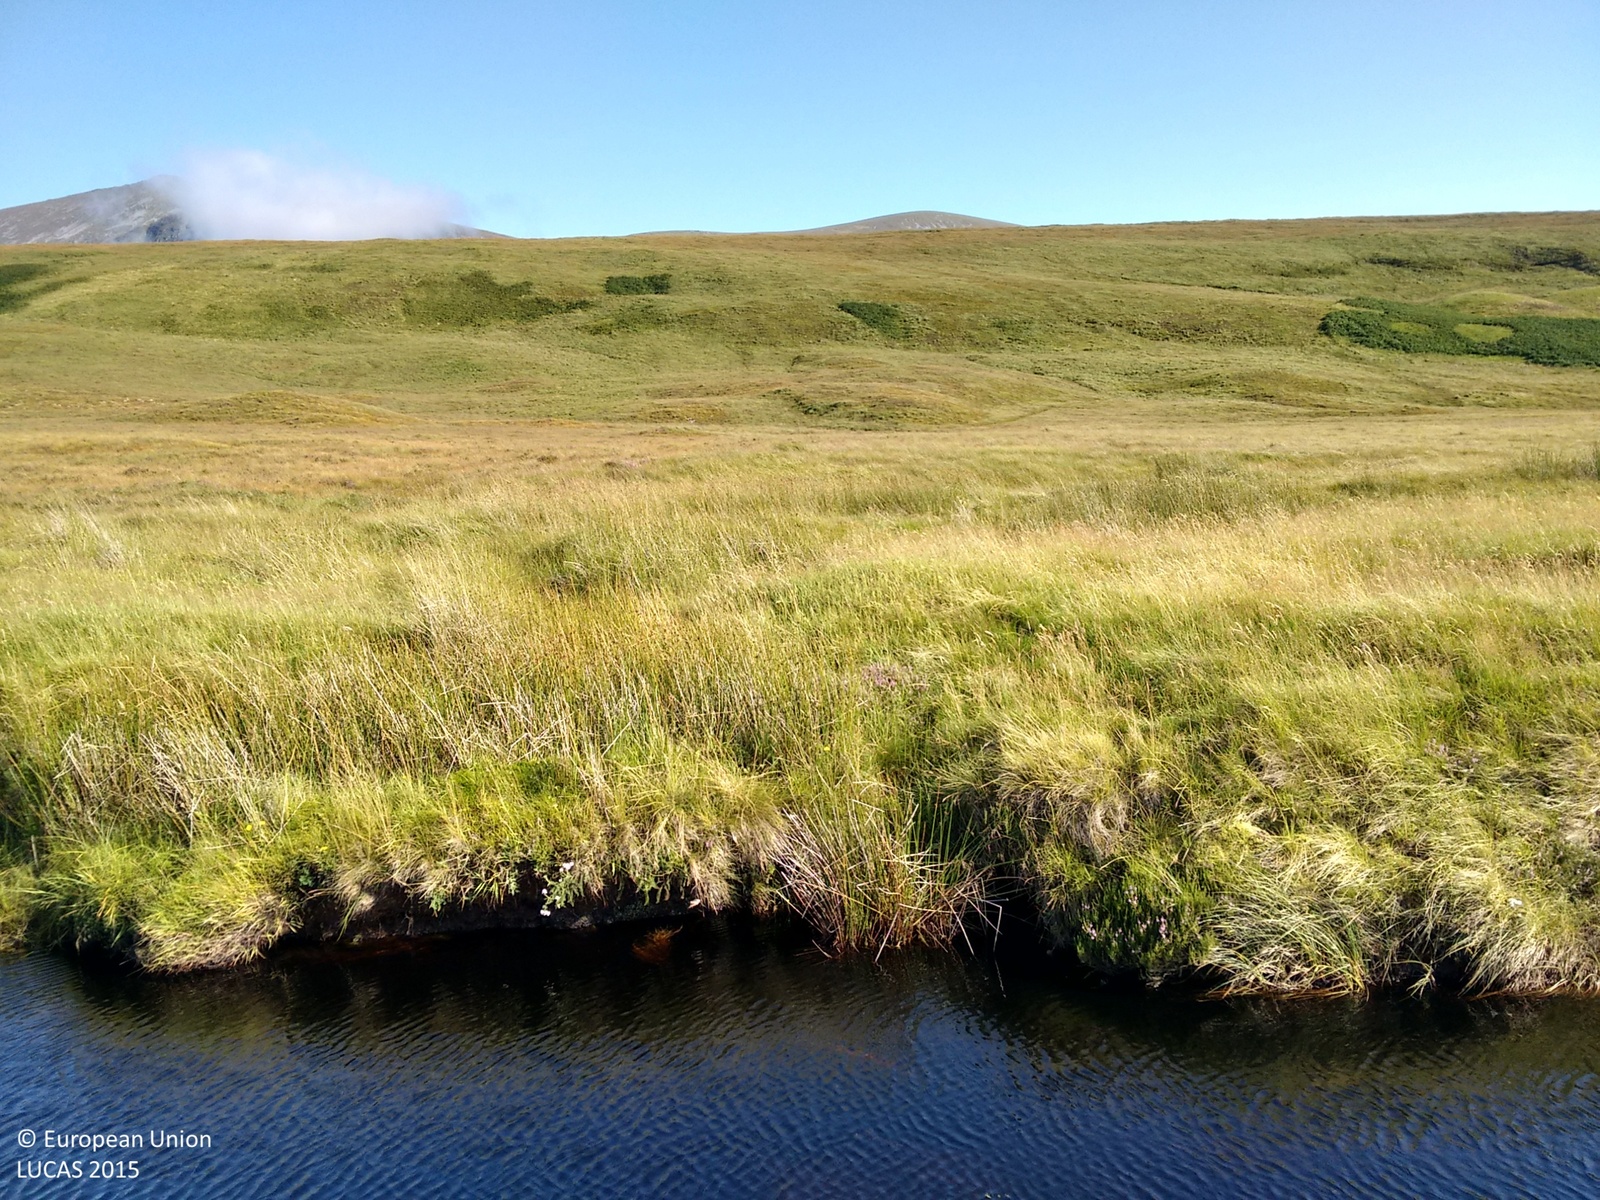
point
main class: Grassland
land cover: Grassland without tree/shrub cover
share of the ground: > 75 %
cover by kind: herbaceous plants 100 %
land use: Agriculture (excluding fallow land and kitchen gardens)
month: September
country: GB
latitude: 58.2359
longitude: -4.4778
